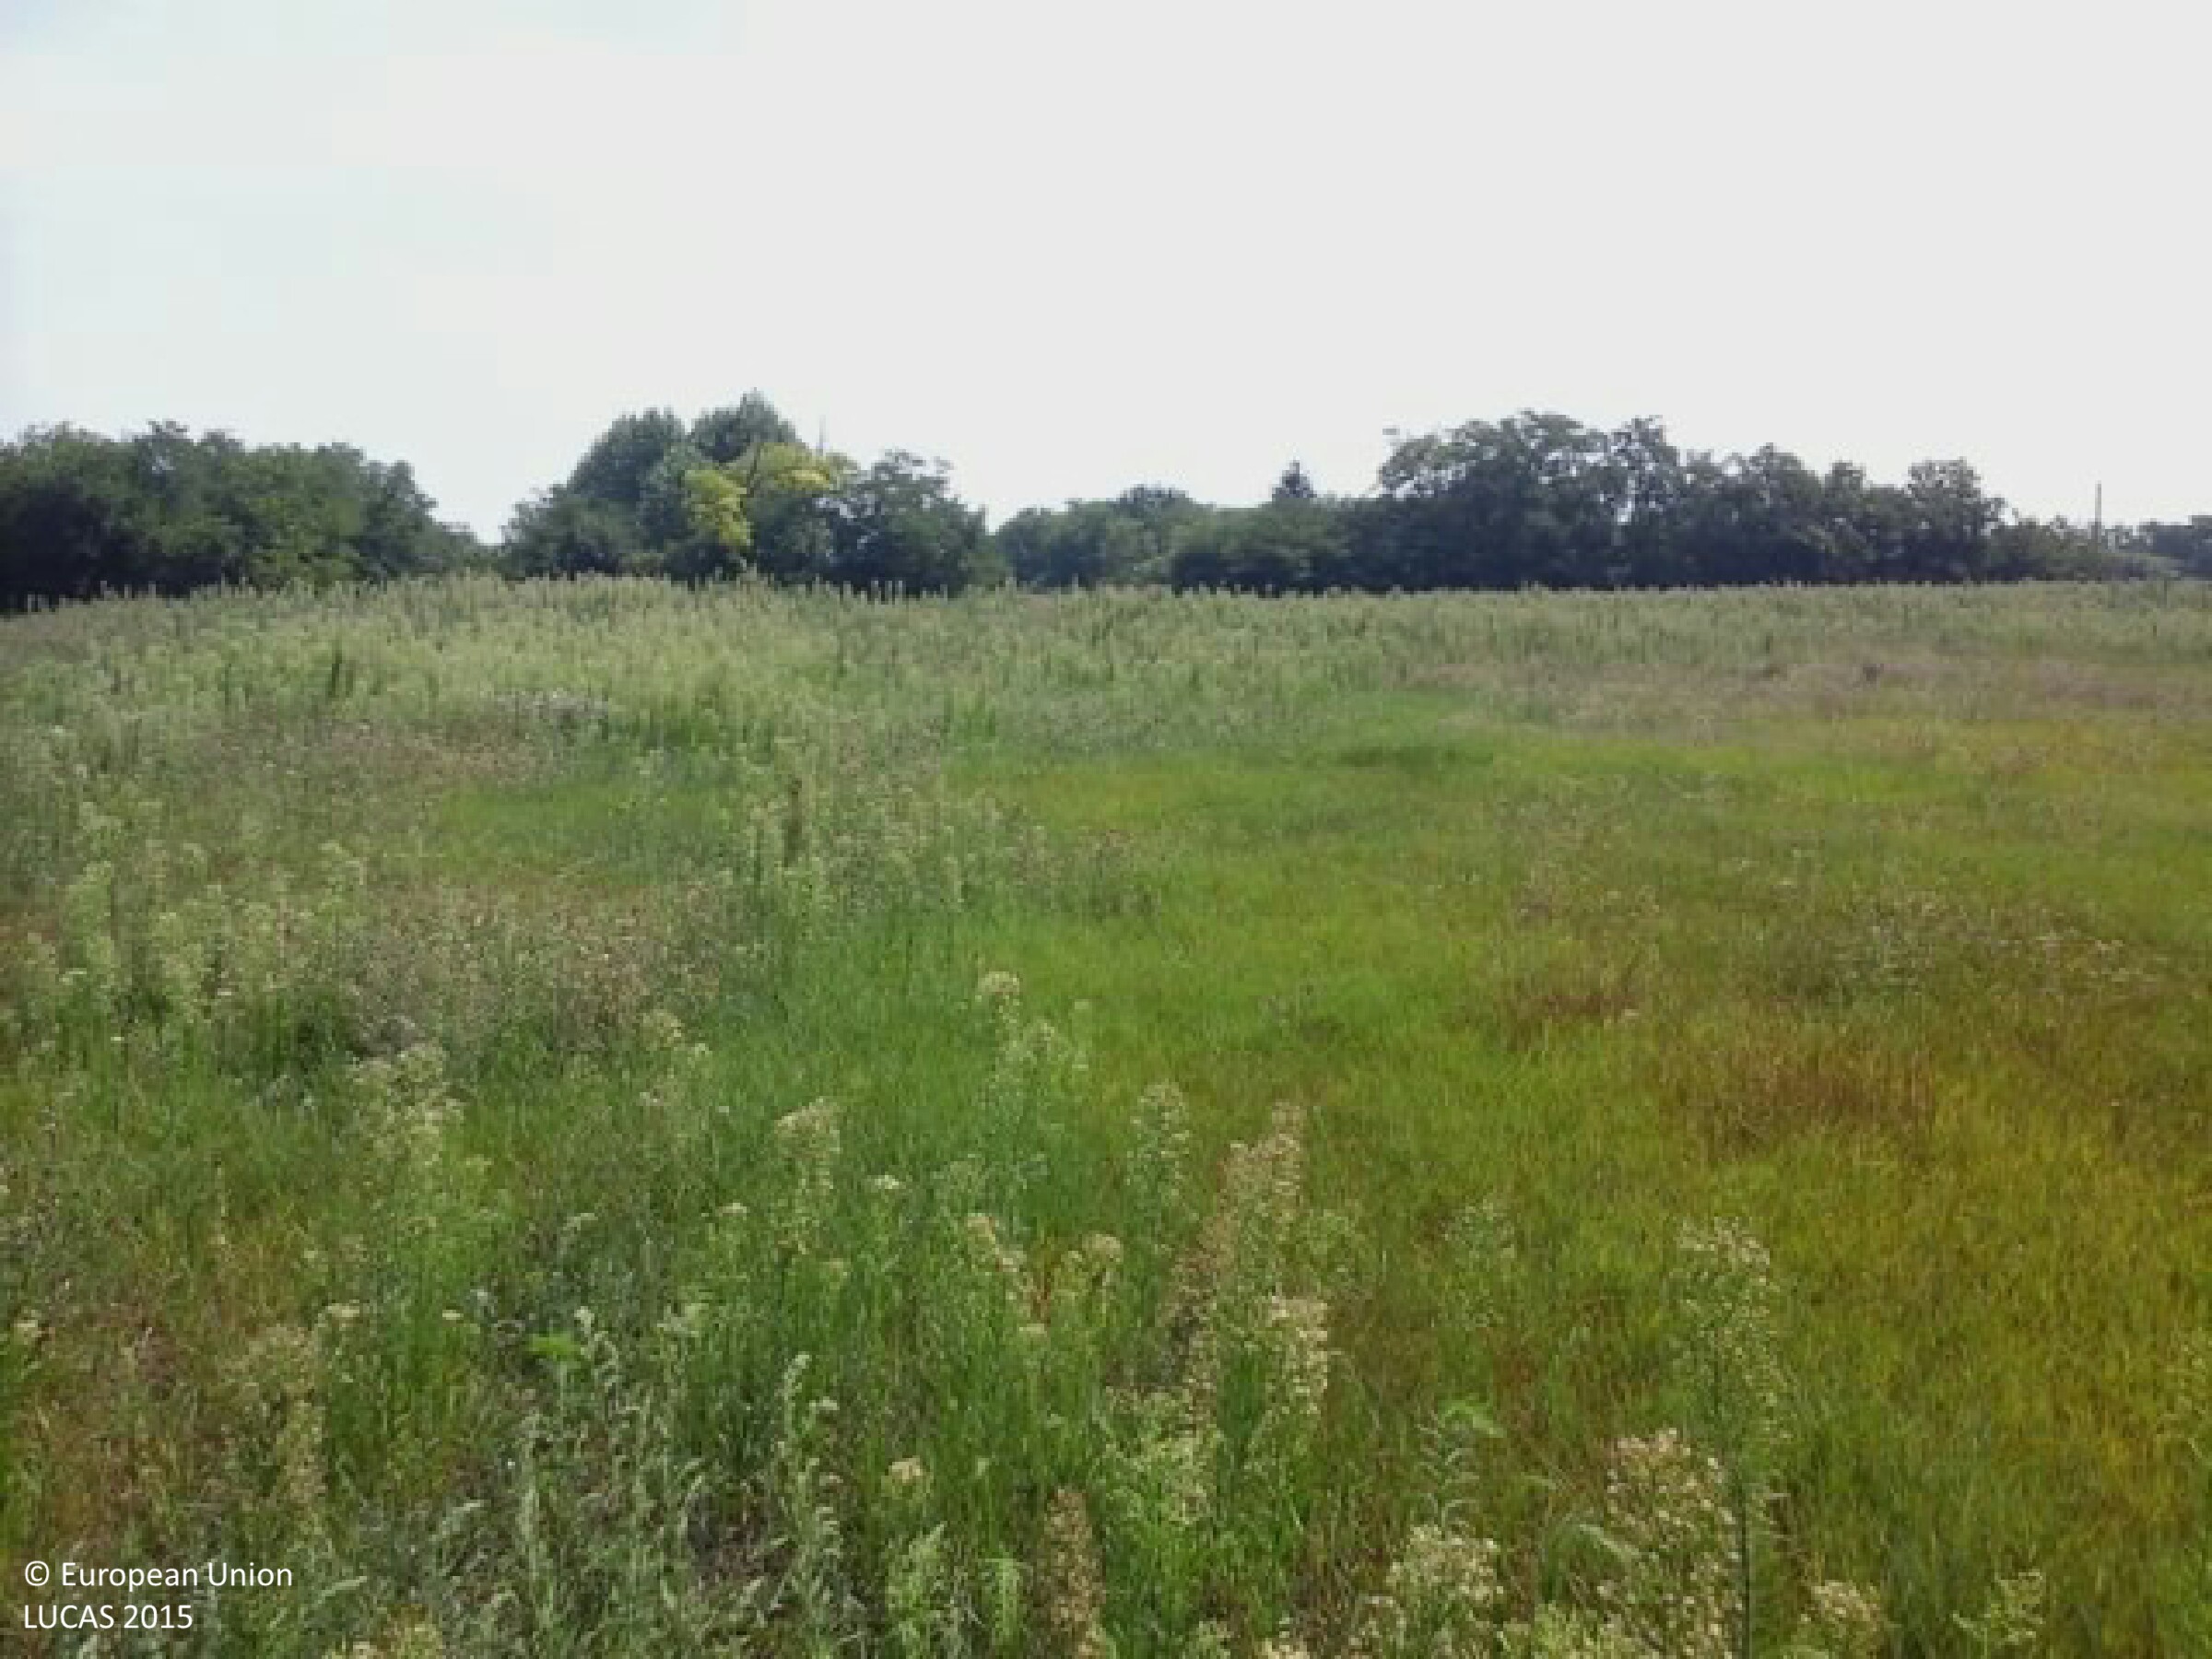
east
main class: Grassland
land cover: Grassland without tree/shrub cover
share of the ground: > 75 %
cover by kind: herbaceous plants 100 %
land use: Agriculture (excluding fallow land and kitchen gardens)
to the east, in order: Grassland without tree/shrub cover; Abandoned hedges; Tracks; Grass margins; Other leguminous and mixtures for fodder; Fences; Broadleaved woodland
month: August
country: HU
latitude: 47.0753
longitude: 19.0108
